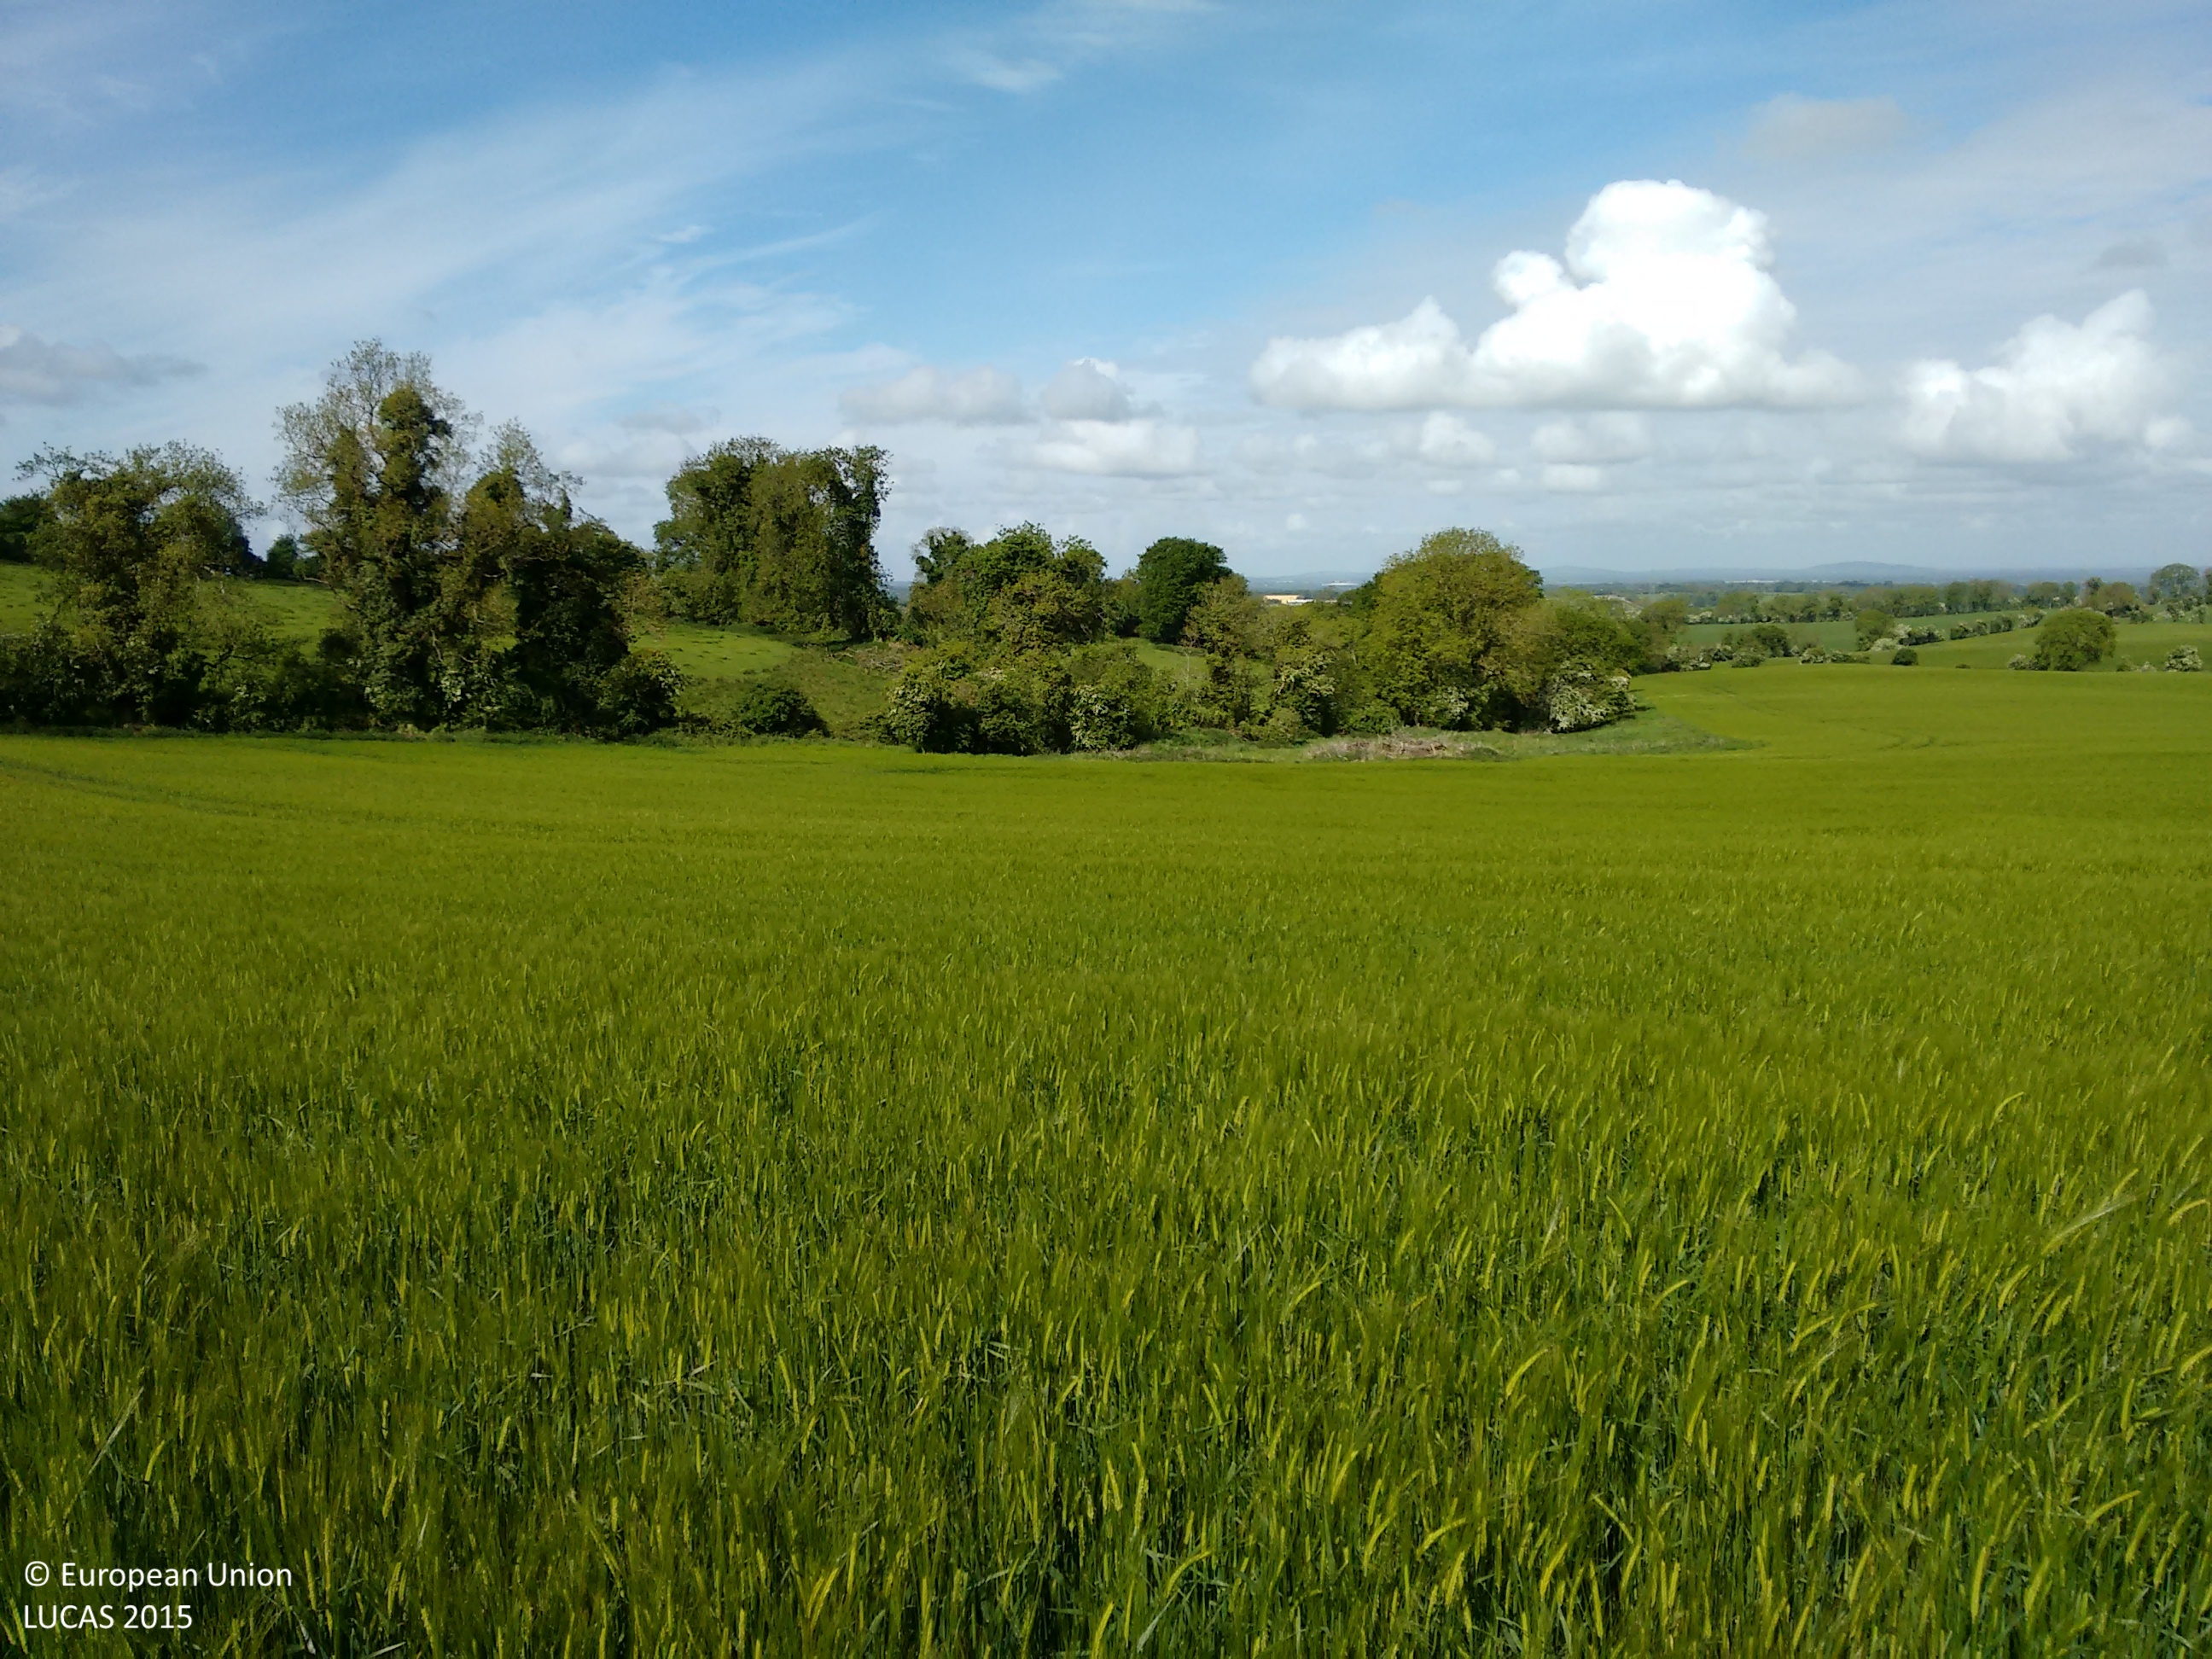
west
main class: Cropland
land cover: Common wheat
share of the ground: > 75 %
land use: Agriculture (excluding fallow land and kitchen gardens)
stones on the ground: < 10 %
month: June
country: IE
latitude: 53.1852
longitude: -6.5756
